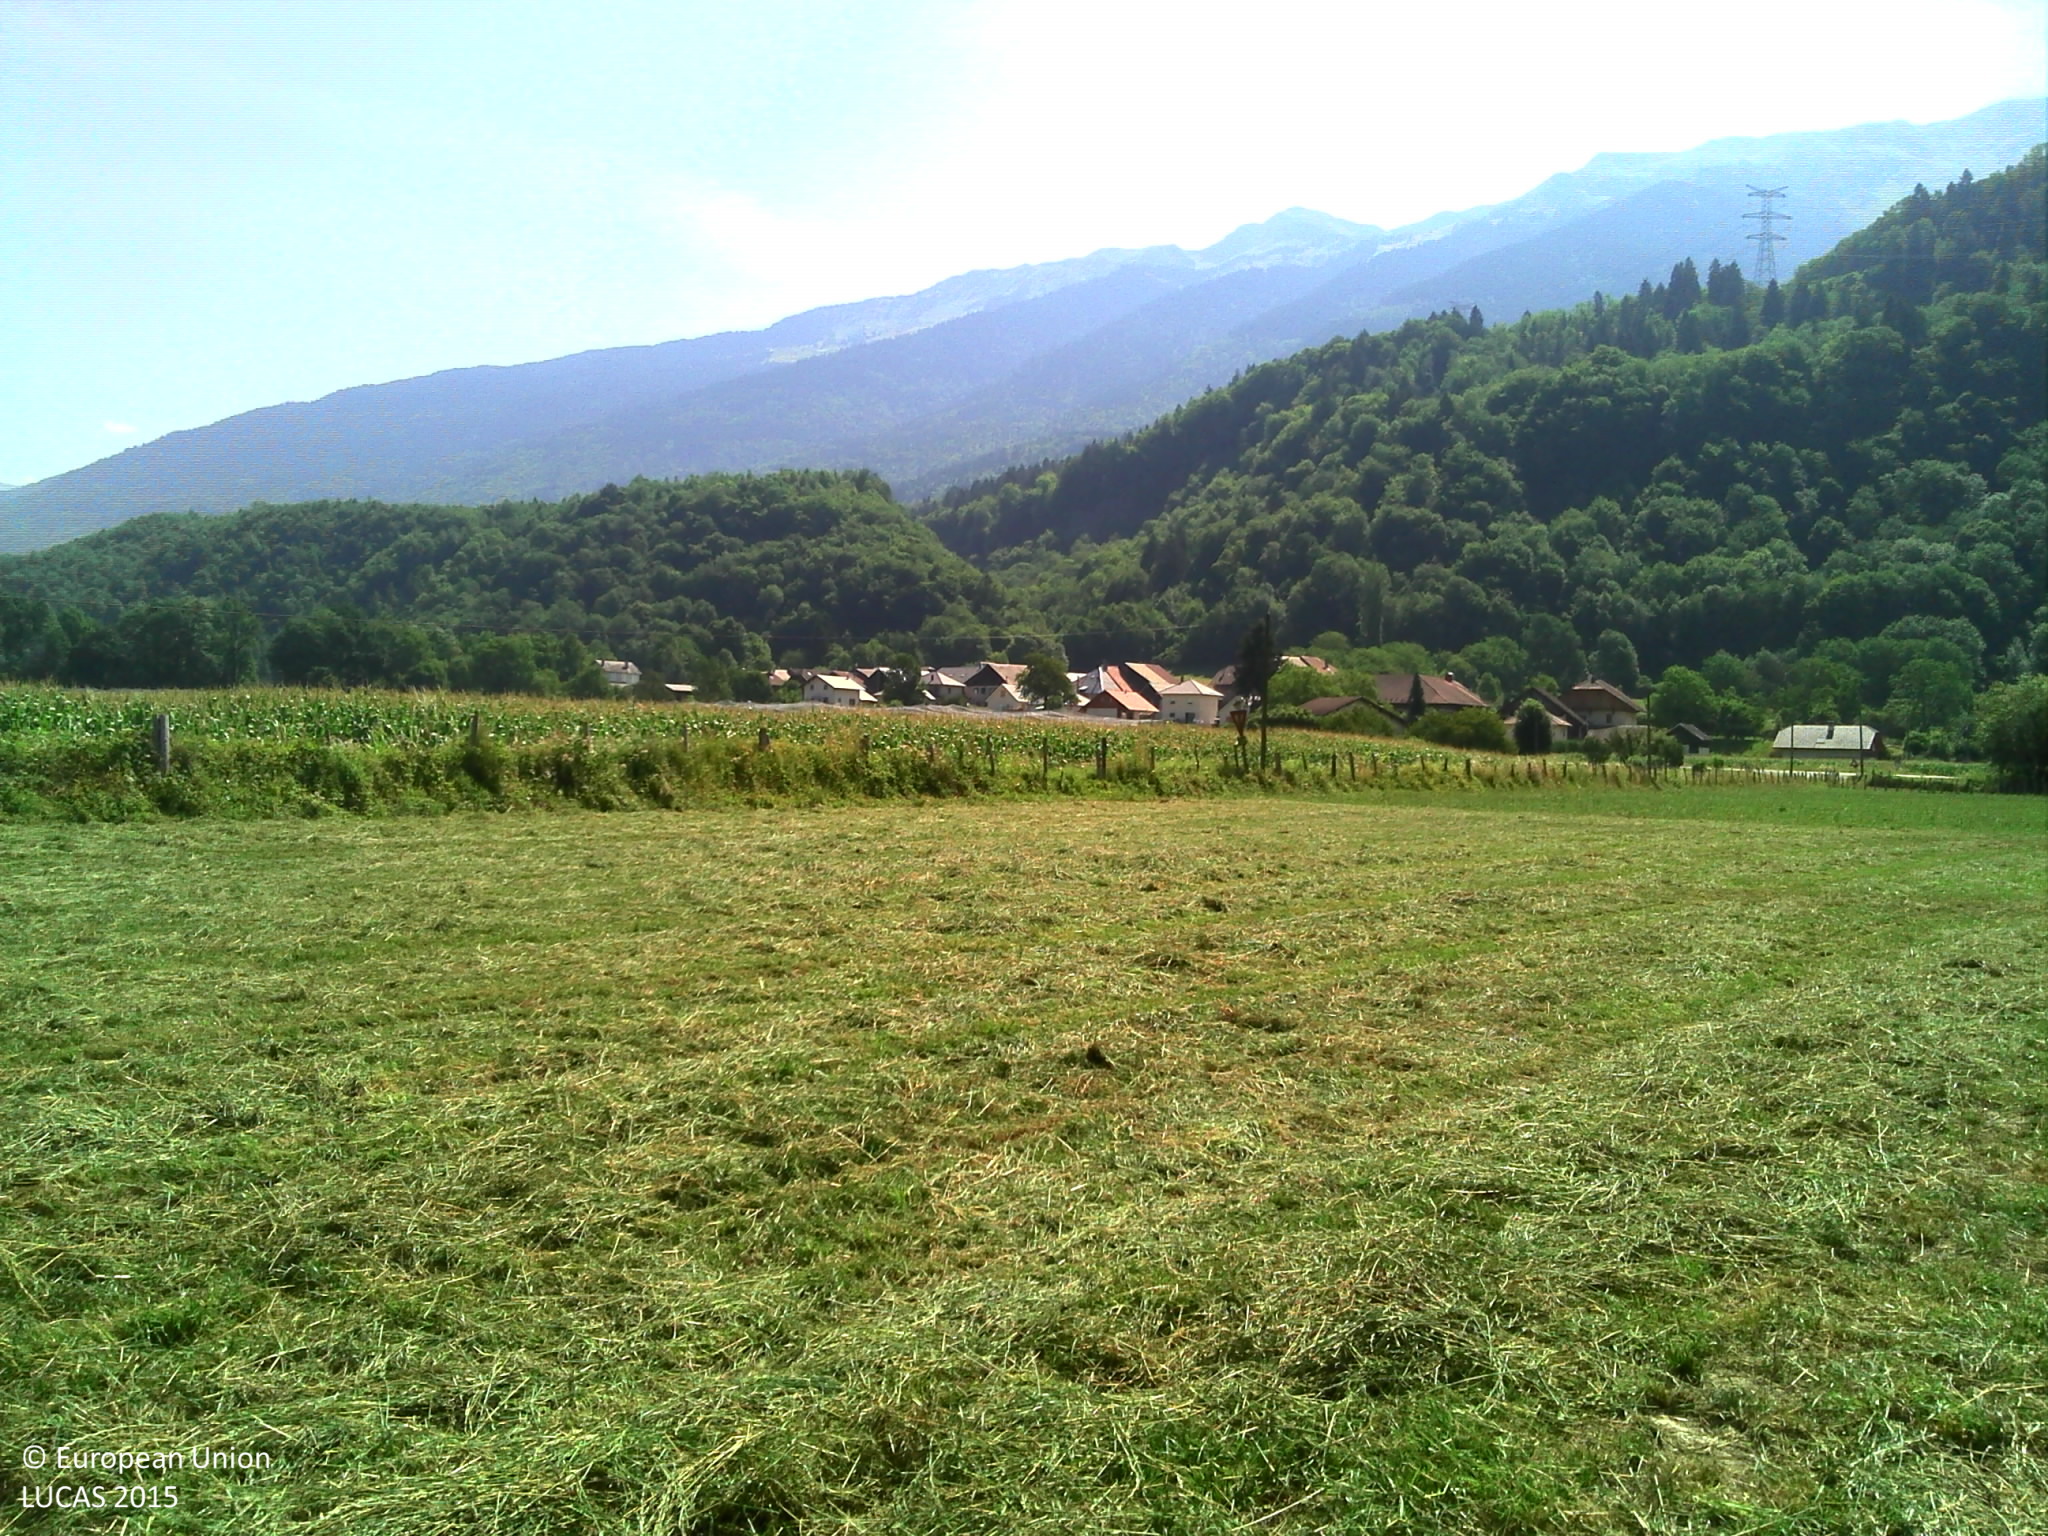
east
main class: Grassland
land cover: Grassland without tree/shrub cover
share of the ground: > 75 %
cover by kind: herbaceous plants 100 %
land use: Agriculture (excluding fallow land and kitchen gardens)
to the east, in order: Grassland without tree/shrub cover; Electric lines; Fences; Paved roads, cycling and walking lanes; Grass margins; Maize; Grassland without tree/shrub cover
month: July
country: FR
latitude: 45.6019
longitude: 6.2993
